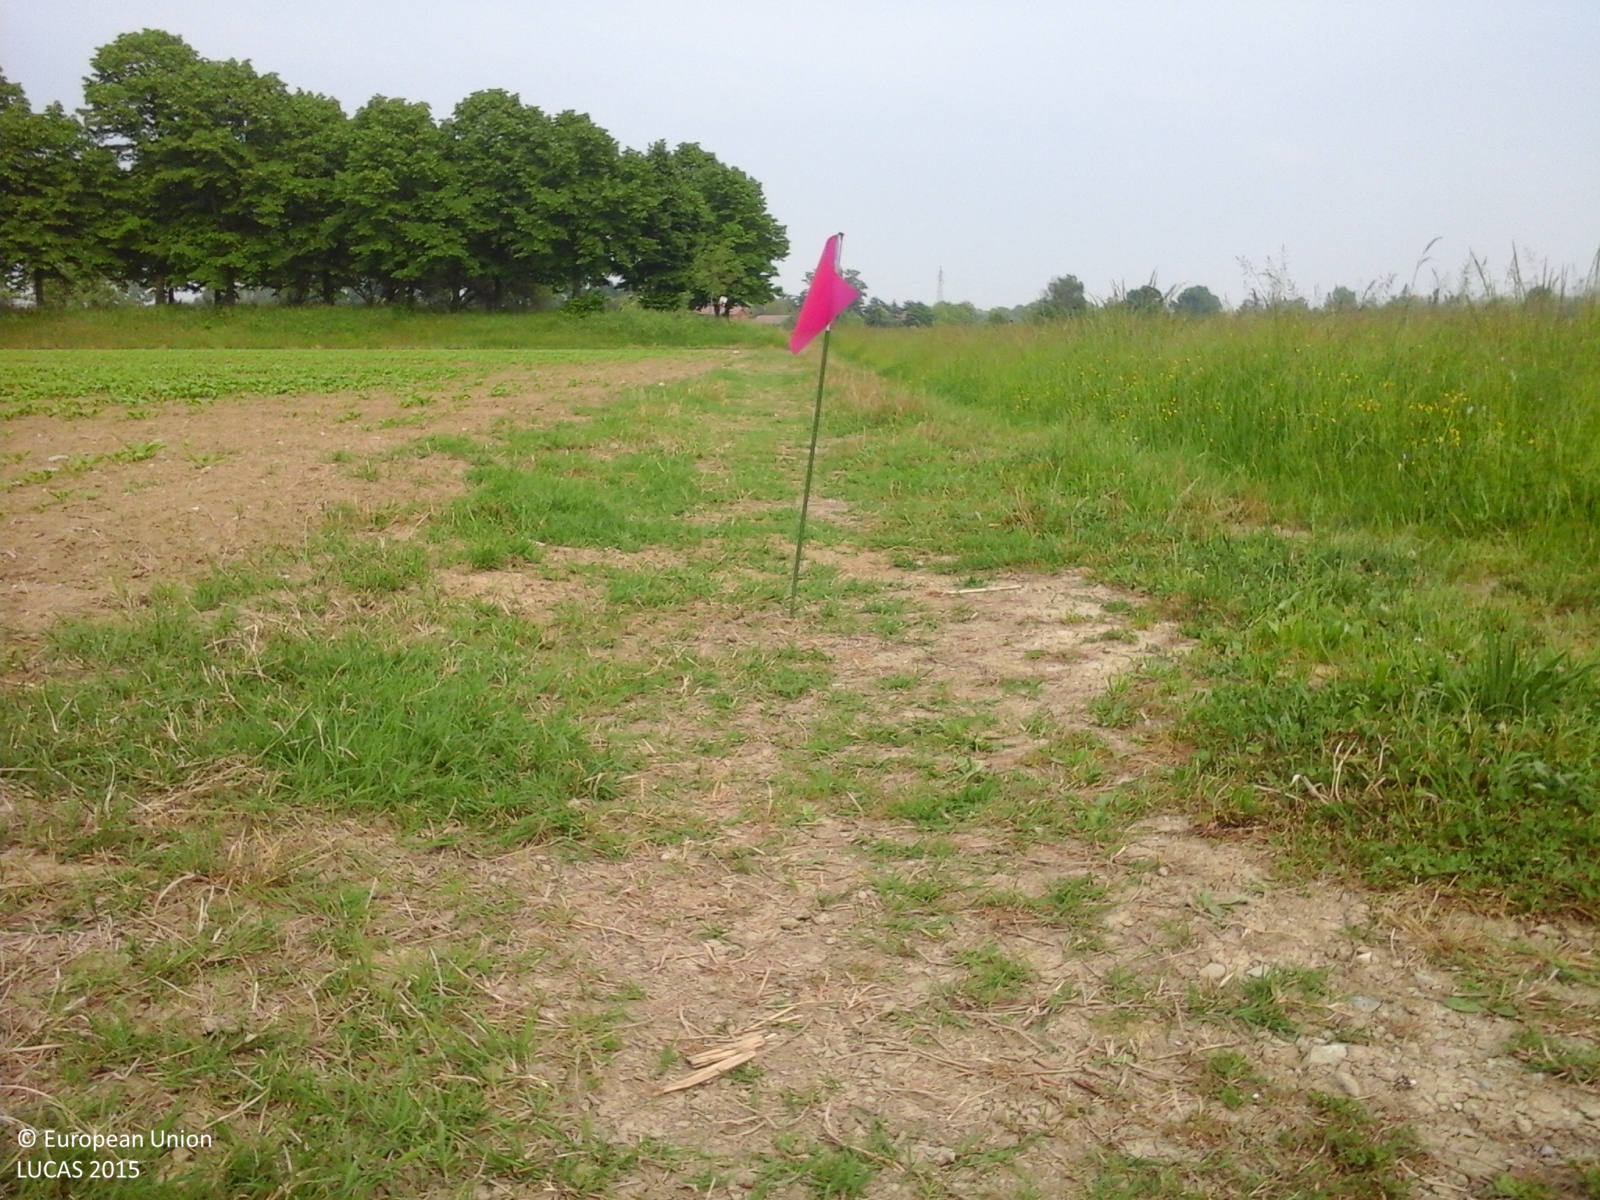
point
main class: Cropland
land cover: Sugar beet
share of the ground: 10 - 25 %
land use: Agriculture (excluding fallow land and kitchen gardens)
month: May
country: IT
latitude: 44.5629
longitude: 10.9171
